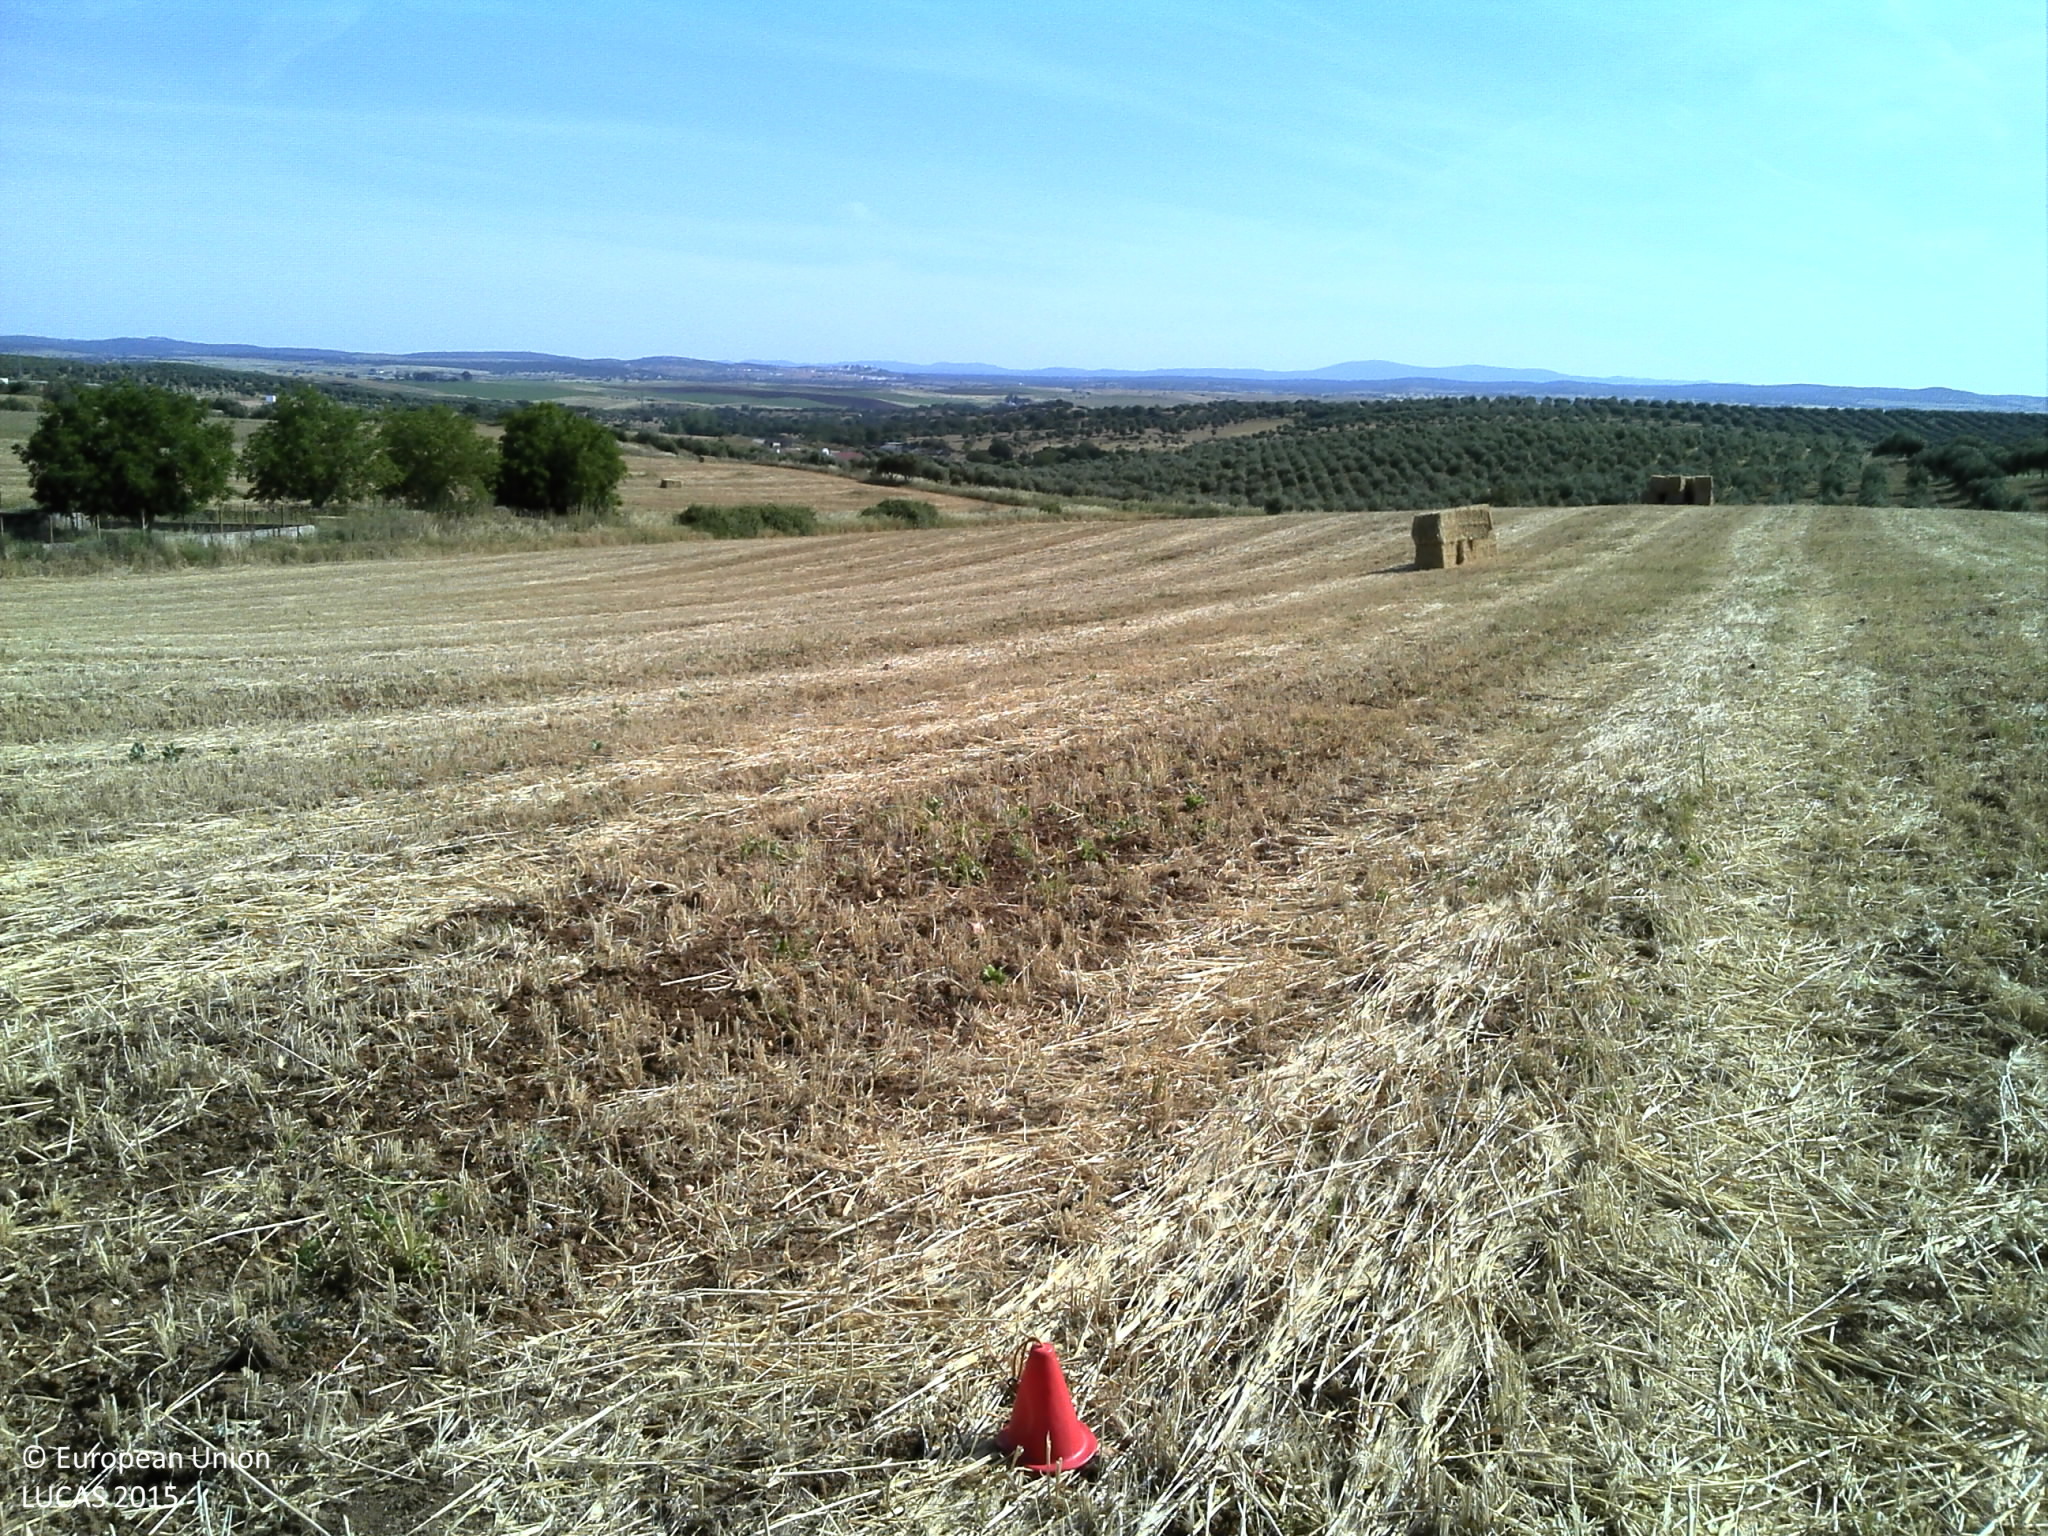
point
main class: Cropland
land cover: Triticale
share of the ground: < 10 %
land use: Agriculture (excluding fallow land and kitchen gardens)
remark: Harvested field
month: May
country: PT
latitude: 39.0429
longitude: -7.6381
